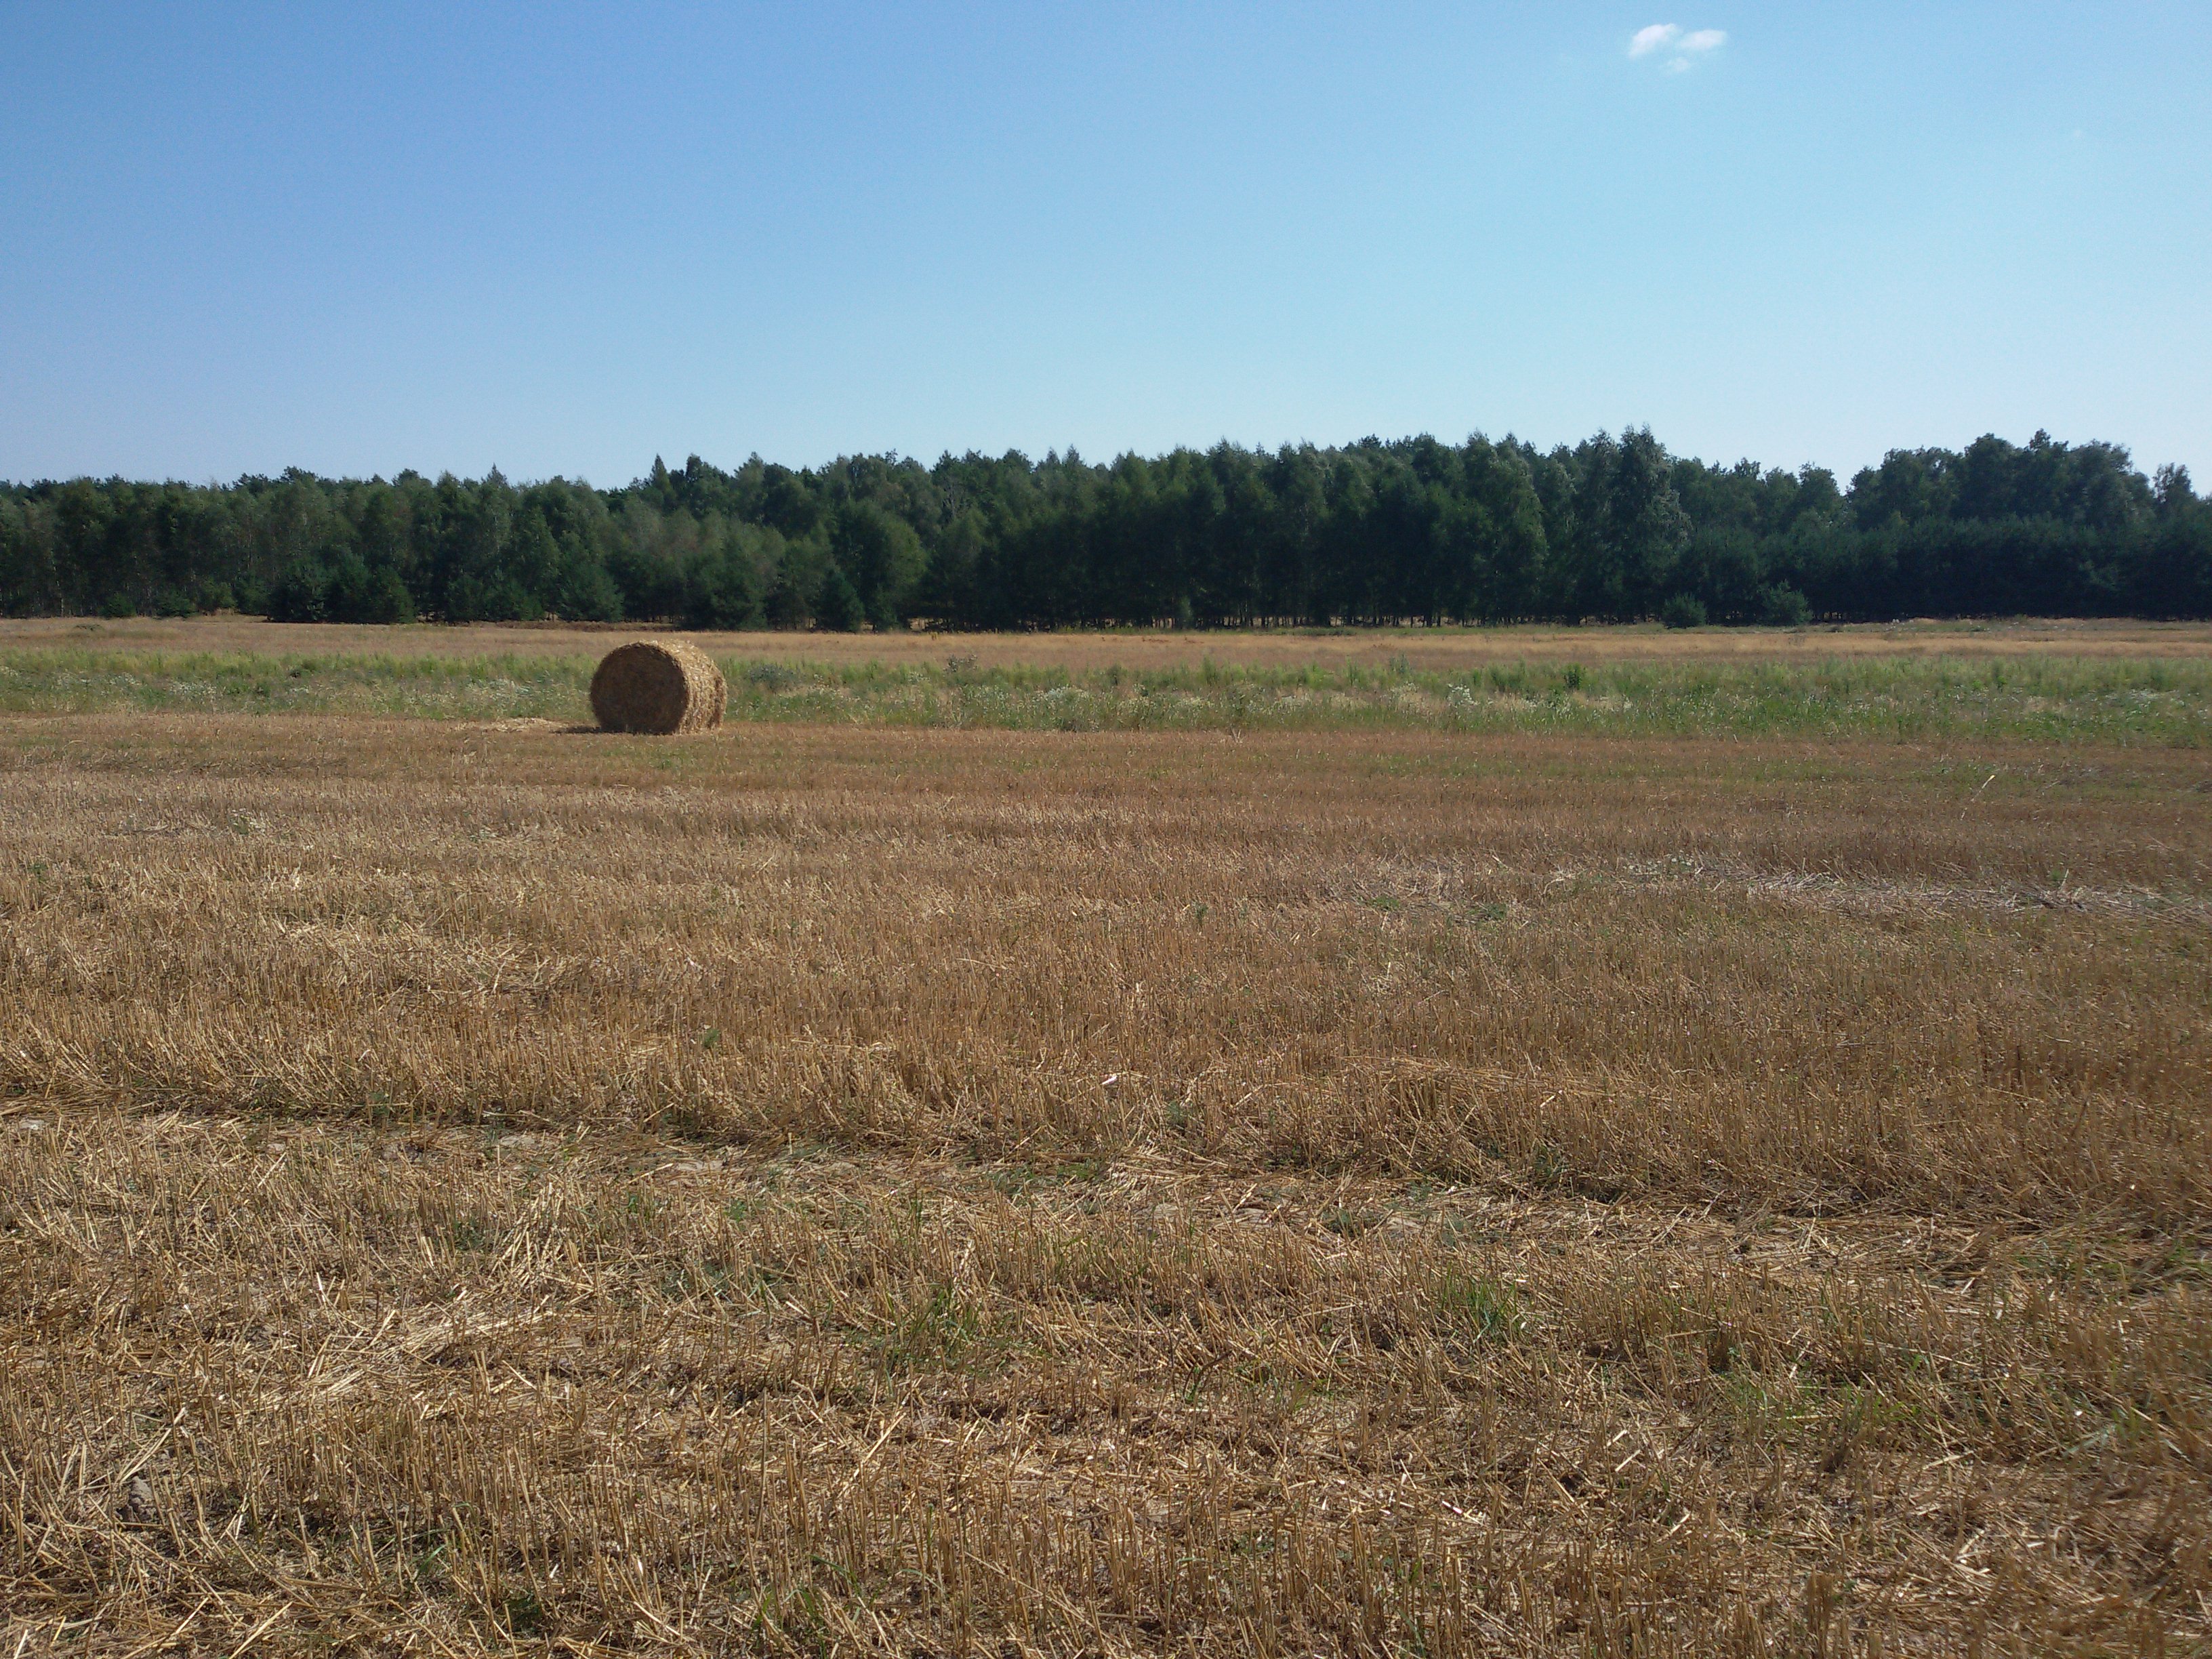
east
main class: Cropland
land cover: Potatoes
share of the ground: 25 - 50 %
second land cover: Spontaneously vegetated surfaces
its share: 50 - 75 %
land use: Agriculture (excluding fallow land and kitchen gardens)
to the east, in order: Tracks; Common wheat; Spontaneously vegetated surfaces; Grassland without tree/shrub cover; Spontaneously vegetated surfaces; Oats; Spontaneously vegetated surfaces; Broadleaved woodland; Grassland without tree/shrub cover; Pine dominated coniferous woodland; Oats
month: August
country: PL
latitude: 52.1982
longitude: 22.0416
